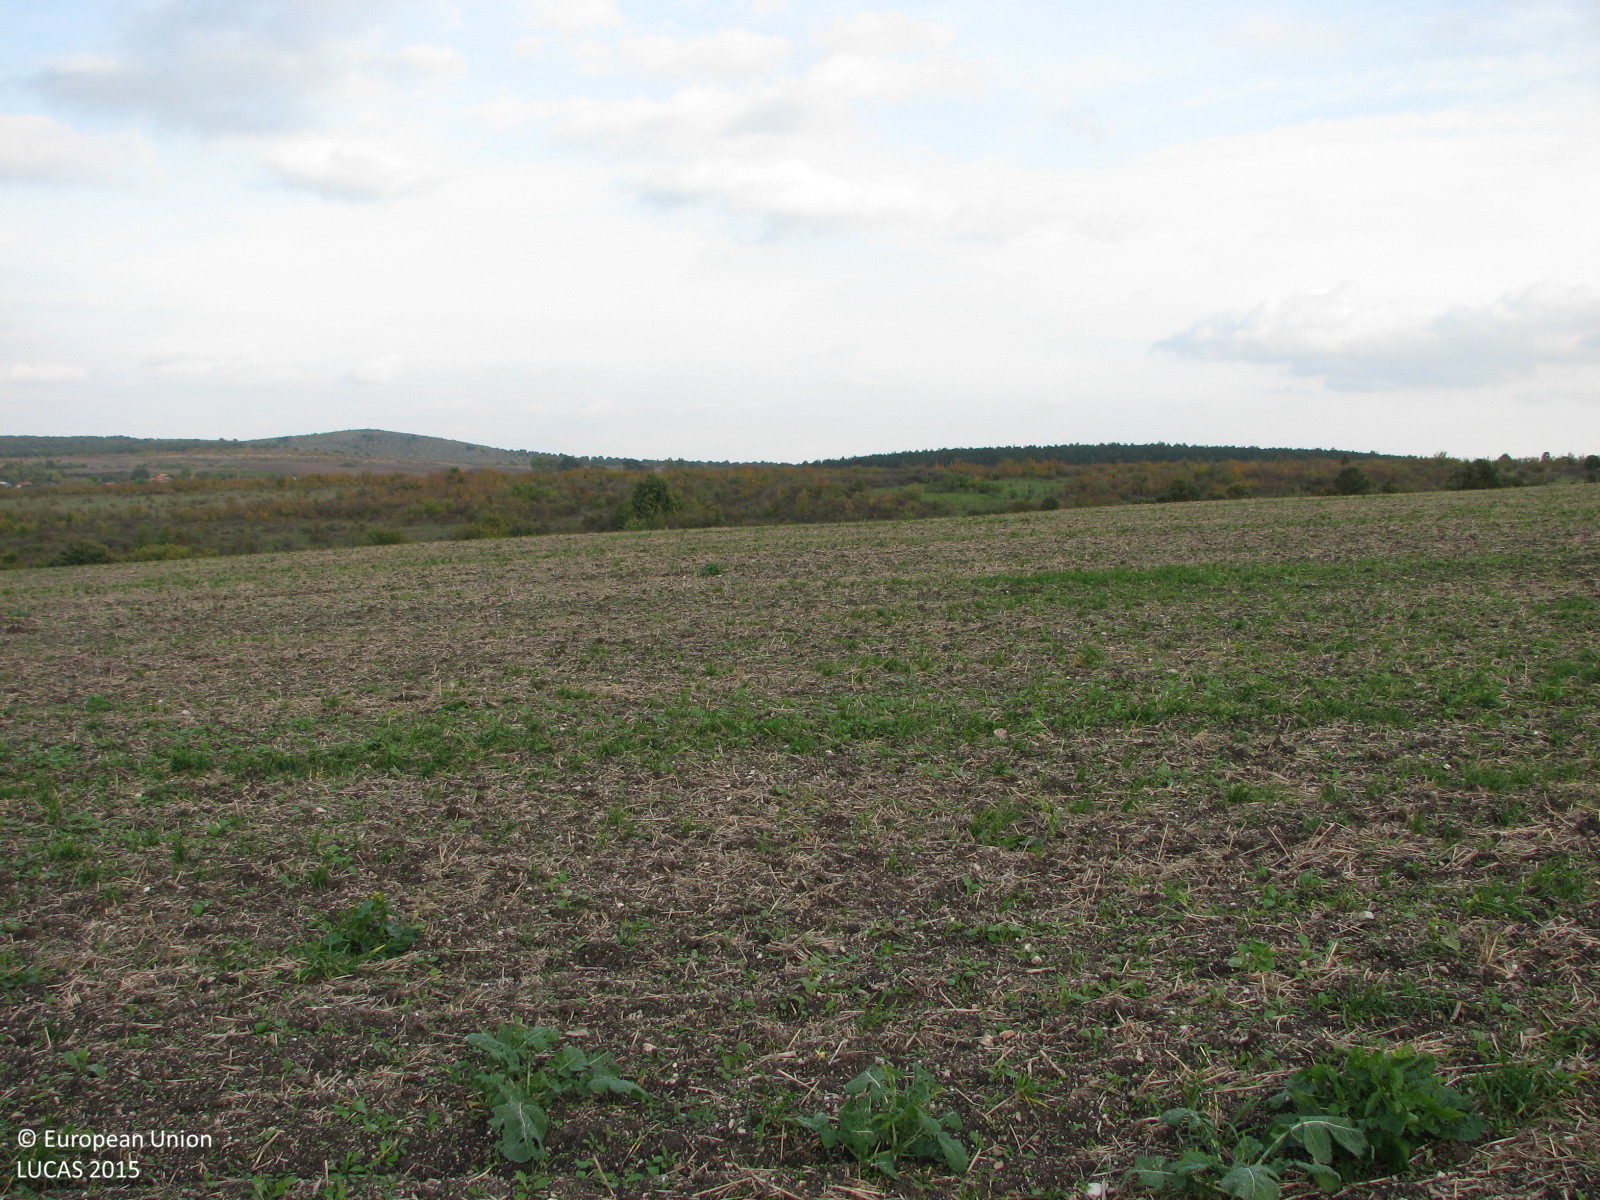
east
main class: Cropland
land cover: Common wheat
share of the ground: 10 - 25 %
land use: Agriculture (excluding fallow land and kitchen gardens)
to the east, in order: Common wheat; Tracks; Shrubland with sparse tree cover; Grassland with sparse tree/shrub cover
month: October
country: BG
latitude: 42.2735
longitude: 26.6681
